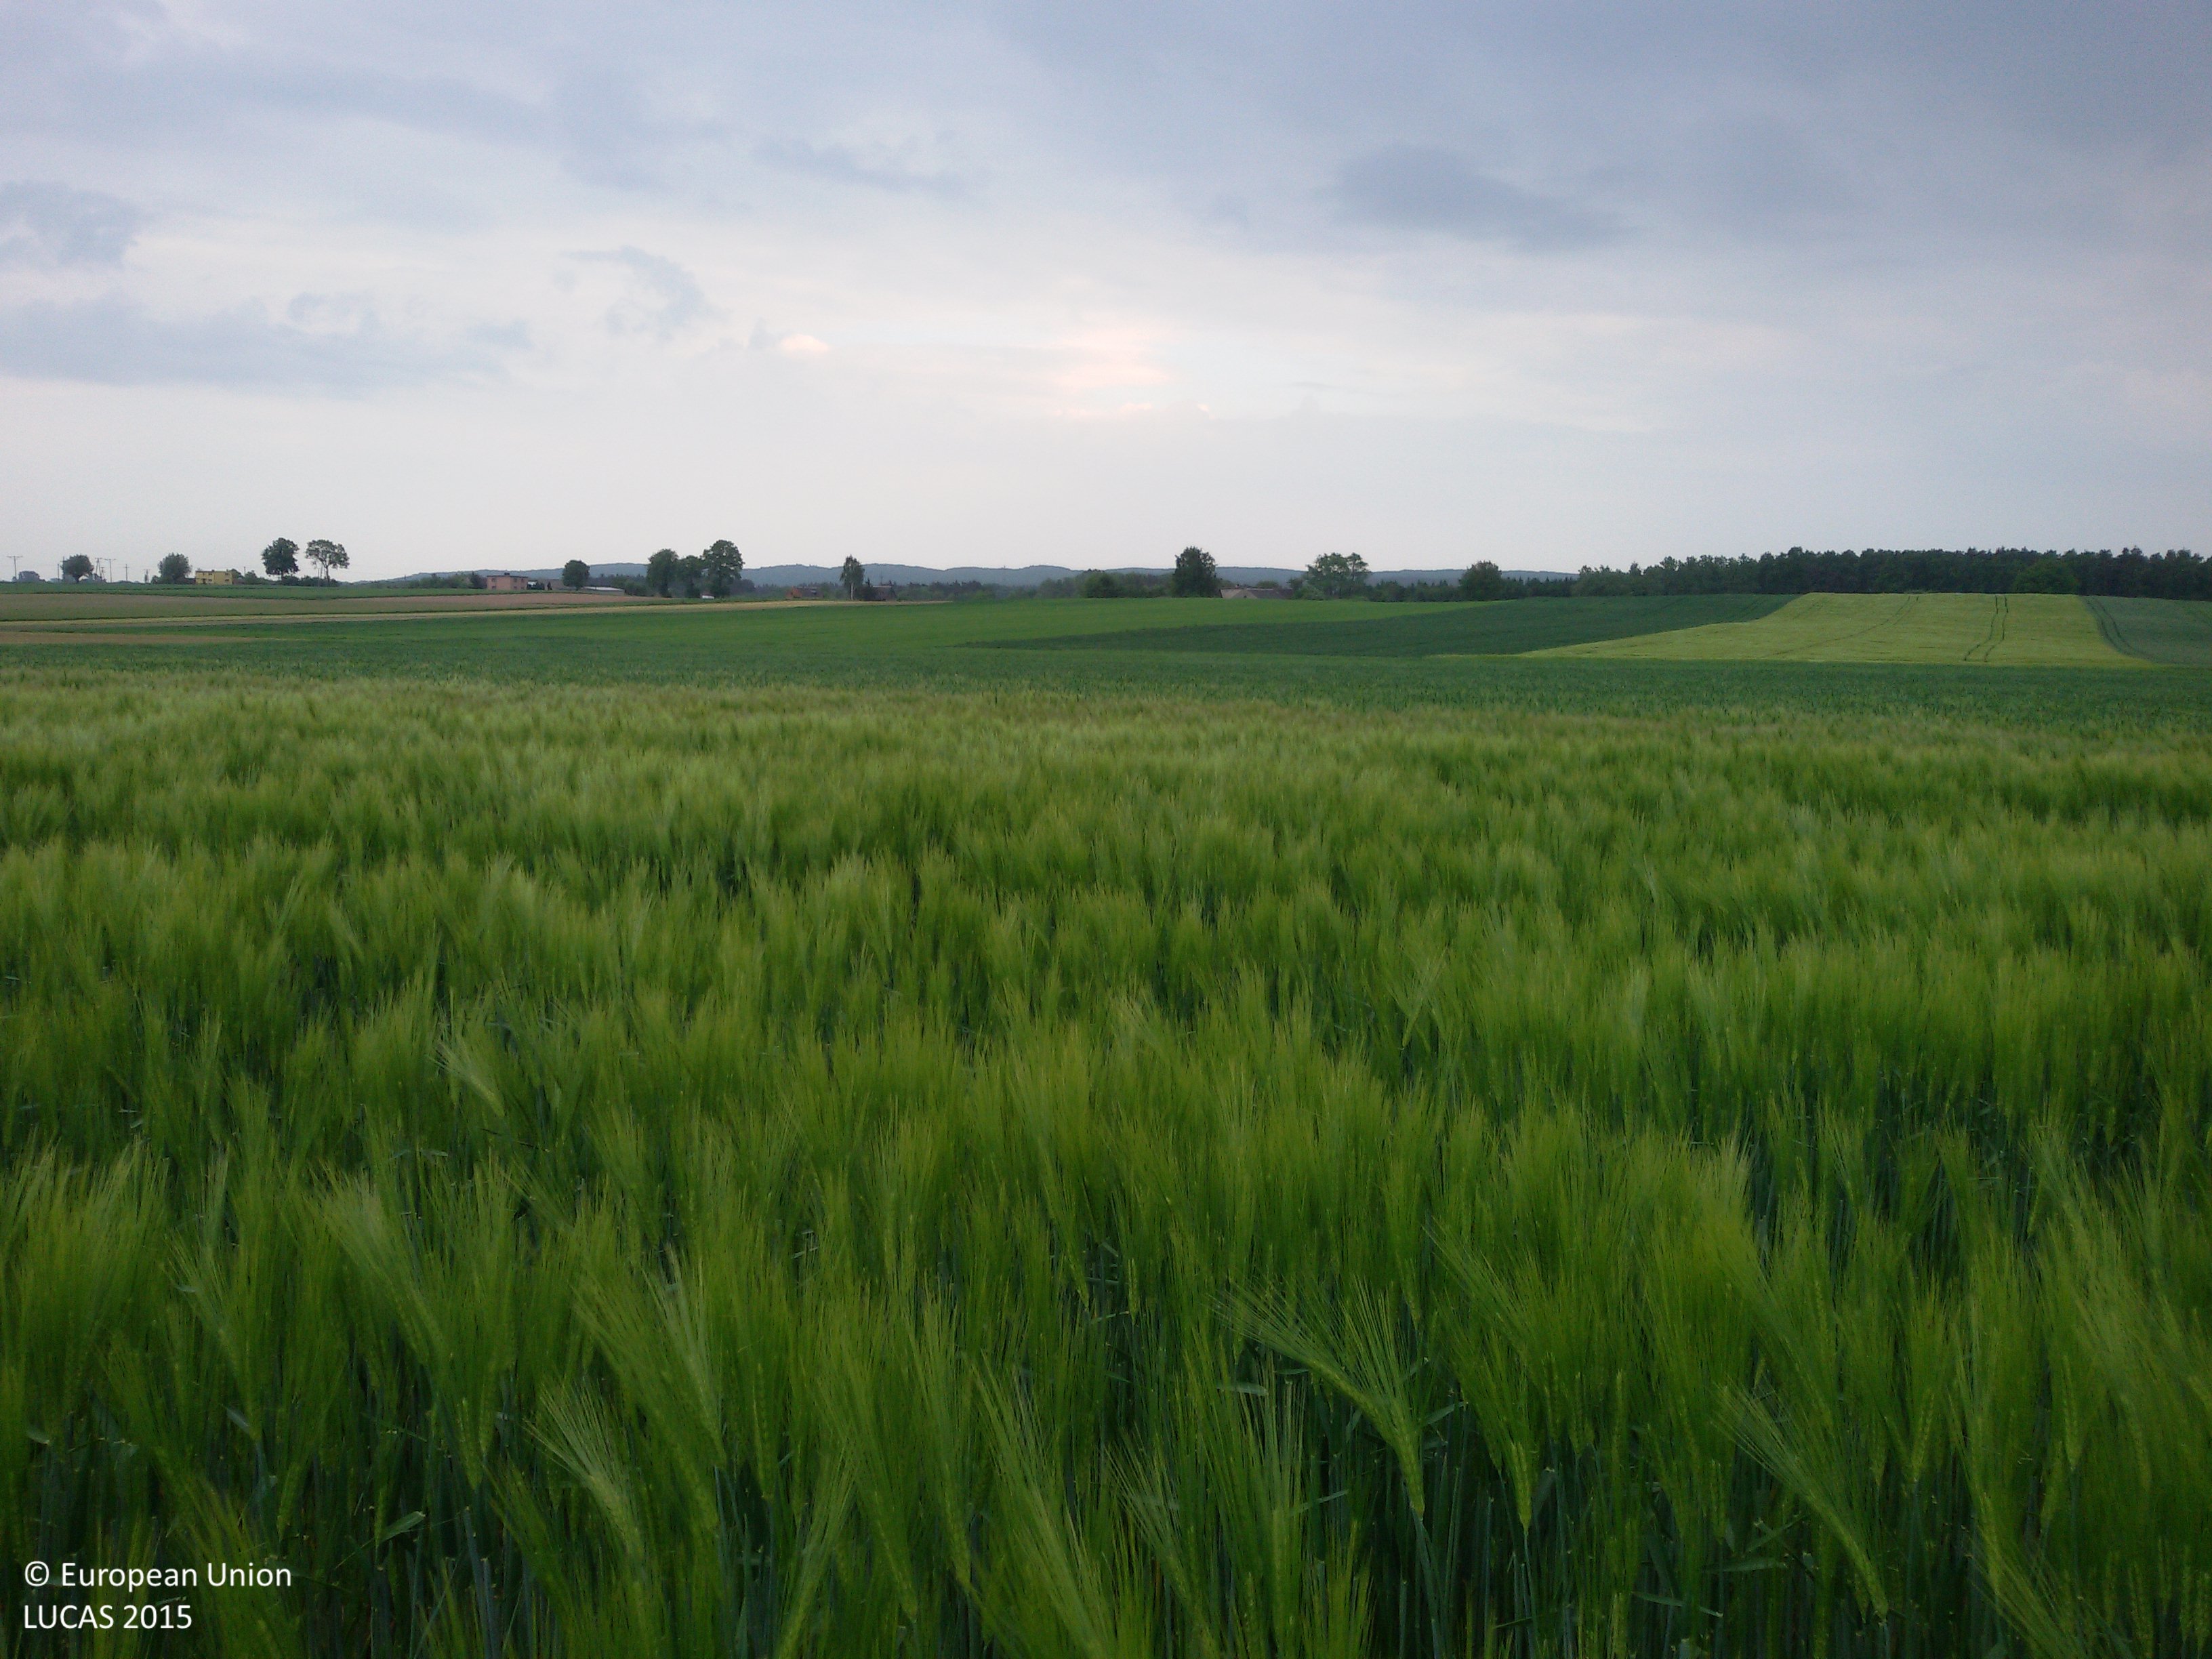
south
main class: Cropland
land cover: Barley
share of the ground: > 75 %
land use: Agriculture (excluding fallow land and kitchen gardens)
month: May
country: PL
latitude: 53.1853
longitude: 17.2385
